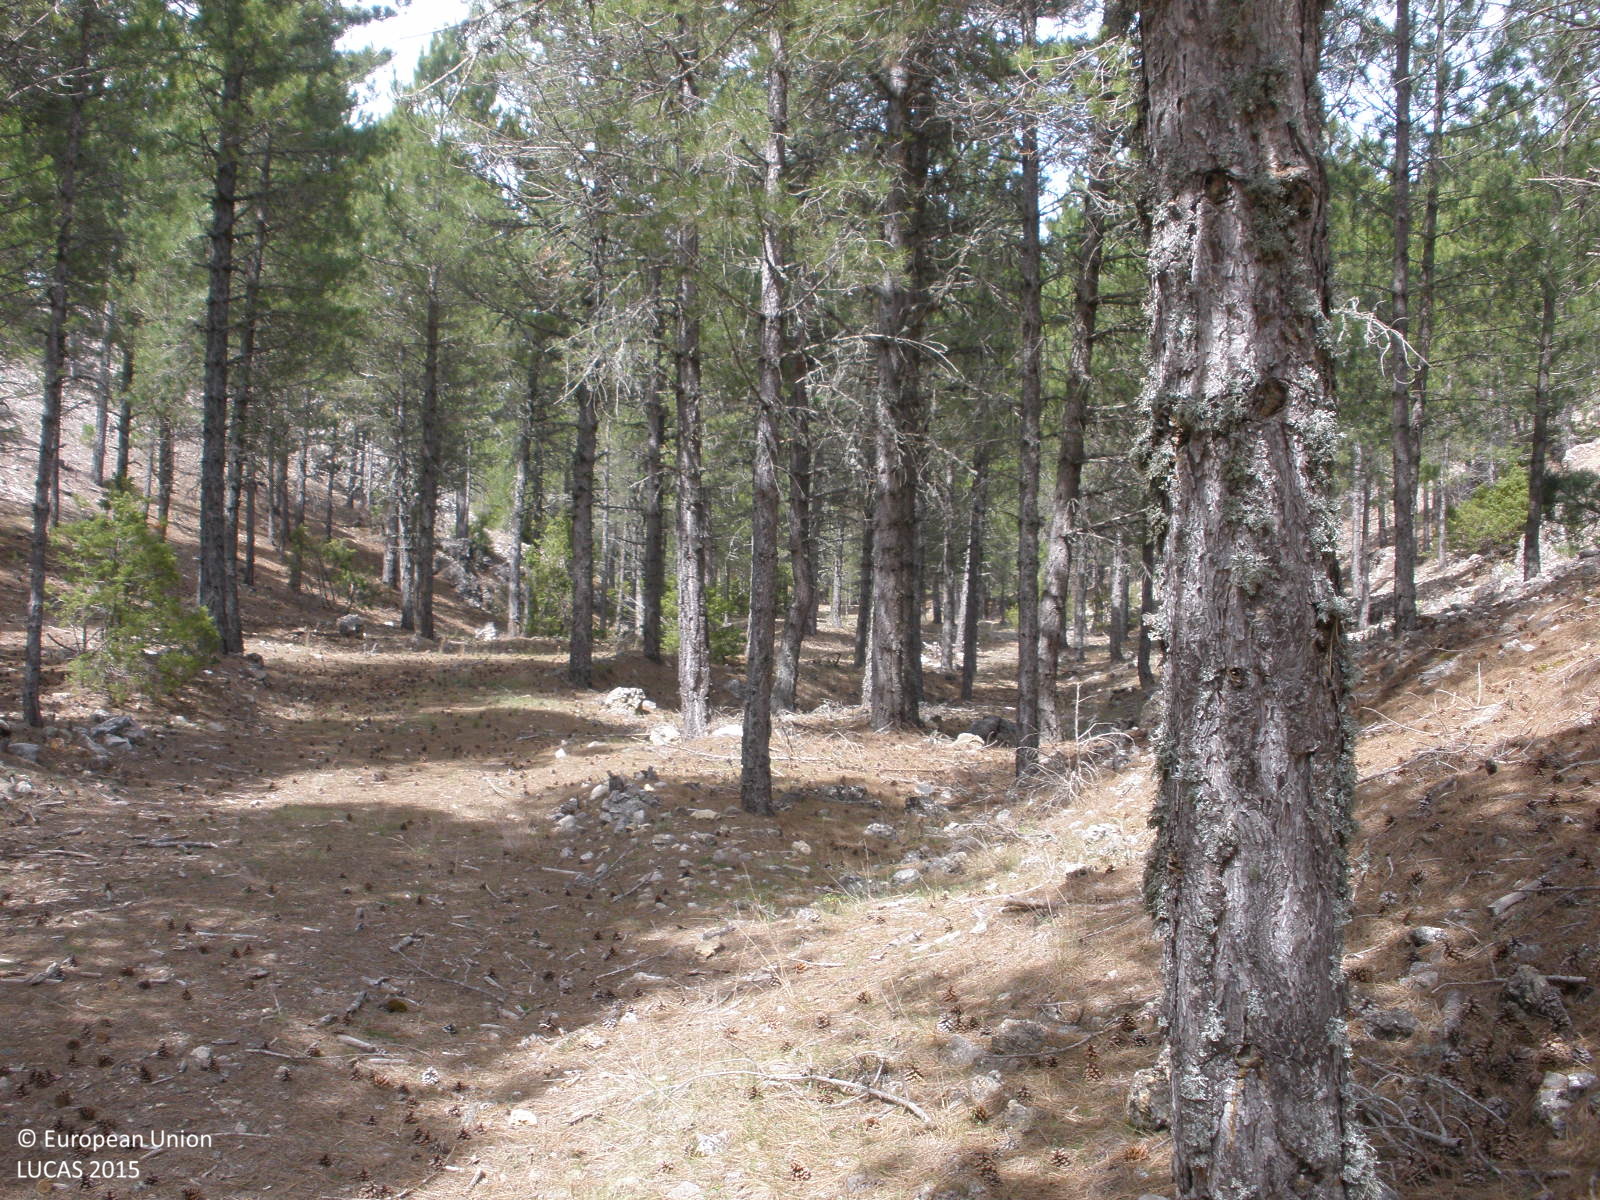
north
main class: Woodland
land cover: Pine dominated coniferous woodland
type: coniferous forest of the mediterranean region
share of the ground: > 75 %
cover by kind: coniferous forest trees 75 %, consolidated bare surface 25 %
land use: Forestry
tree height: > 5 m
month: April
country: ES
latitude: 40.1898
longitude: -1.0379
